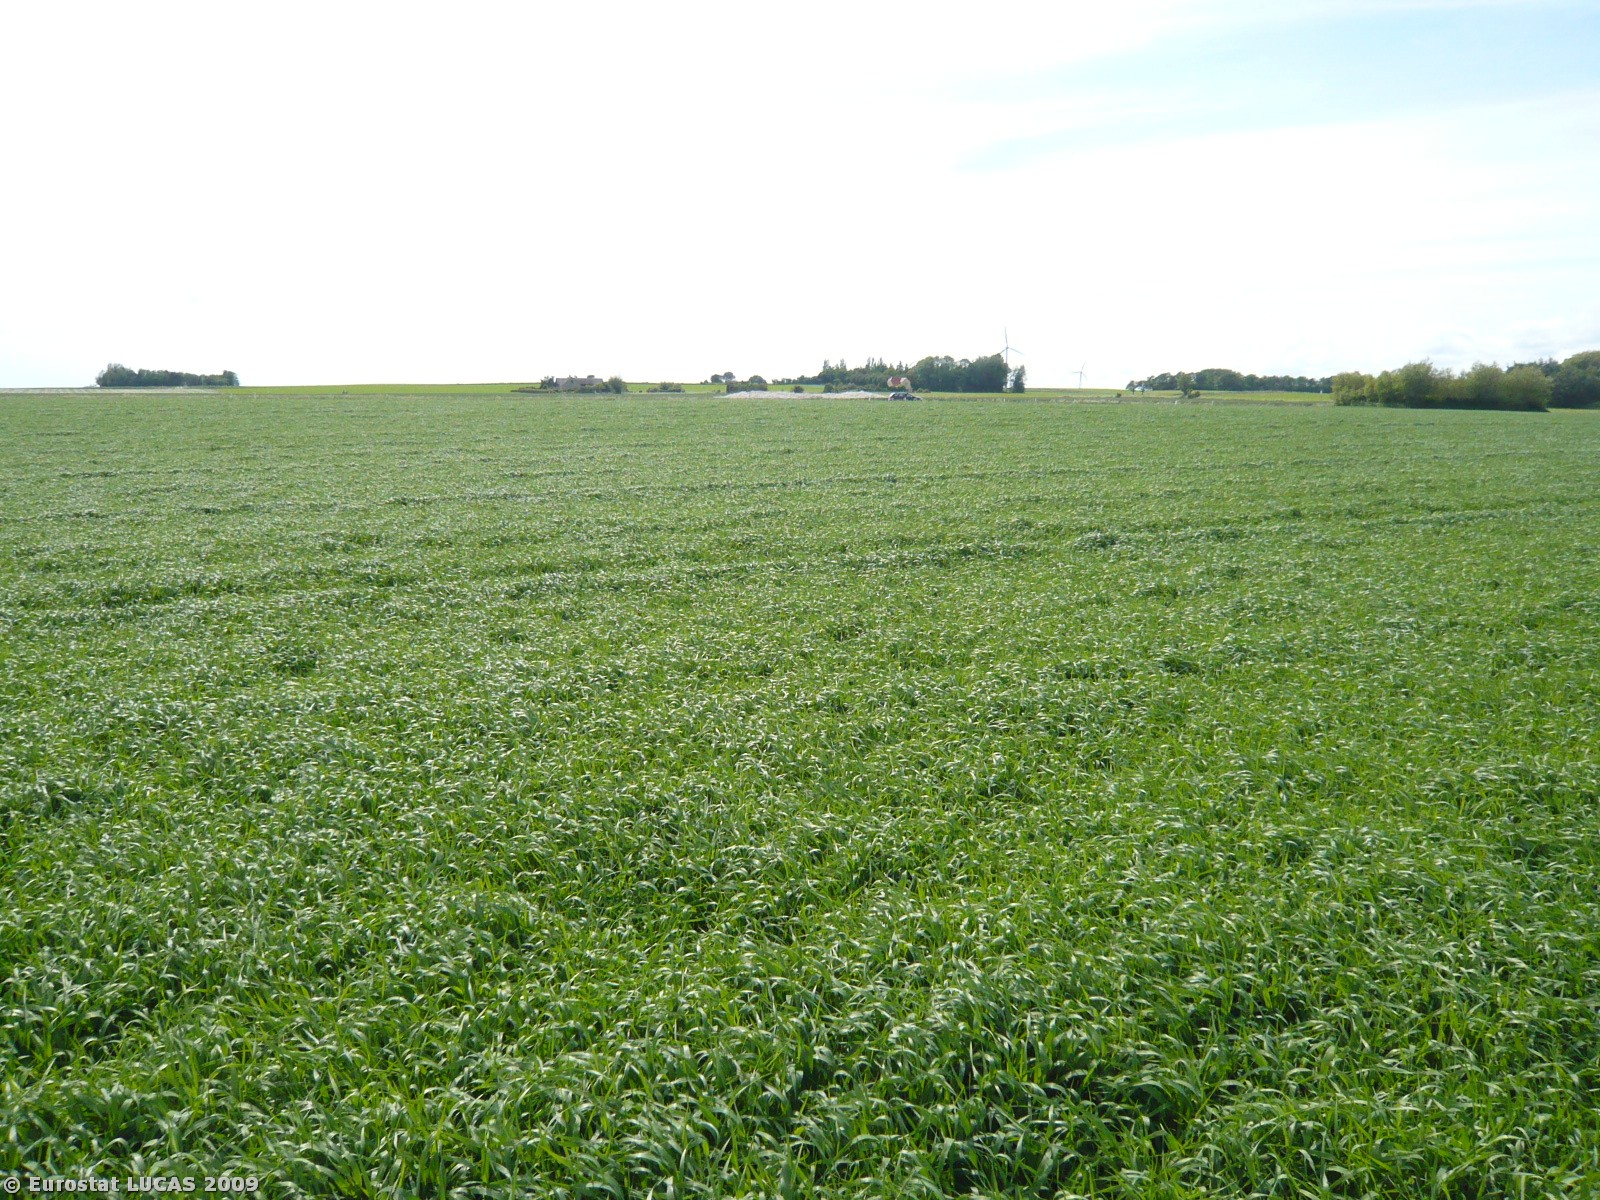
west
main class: Cropland
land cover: Barley
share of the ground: > 75 %
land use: Agriculture (excluding fallow land and kitchen gardens)
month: June
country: DK
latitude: 54.6090
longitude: 11.9342
